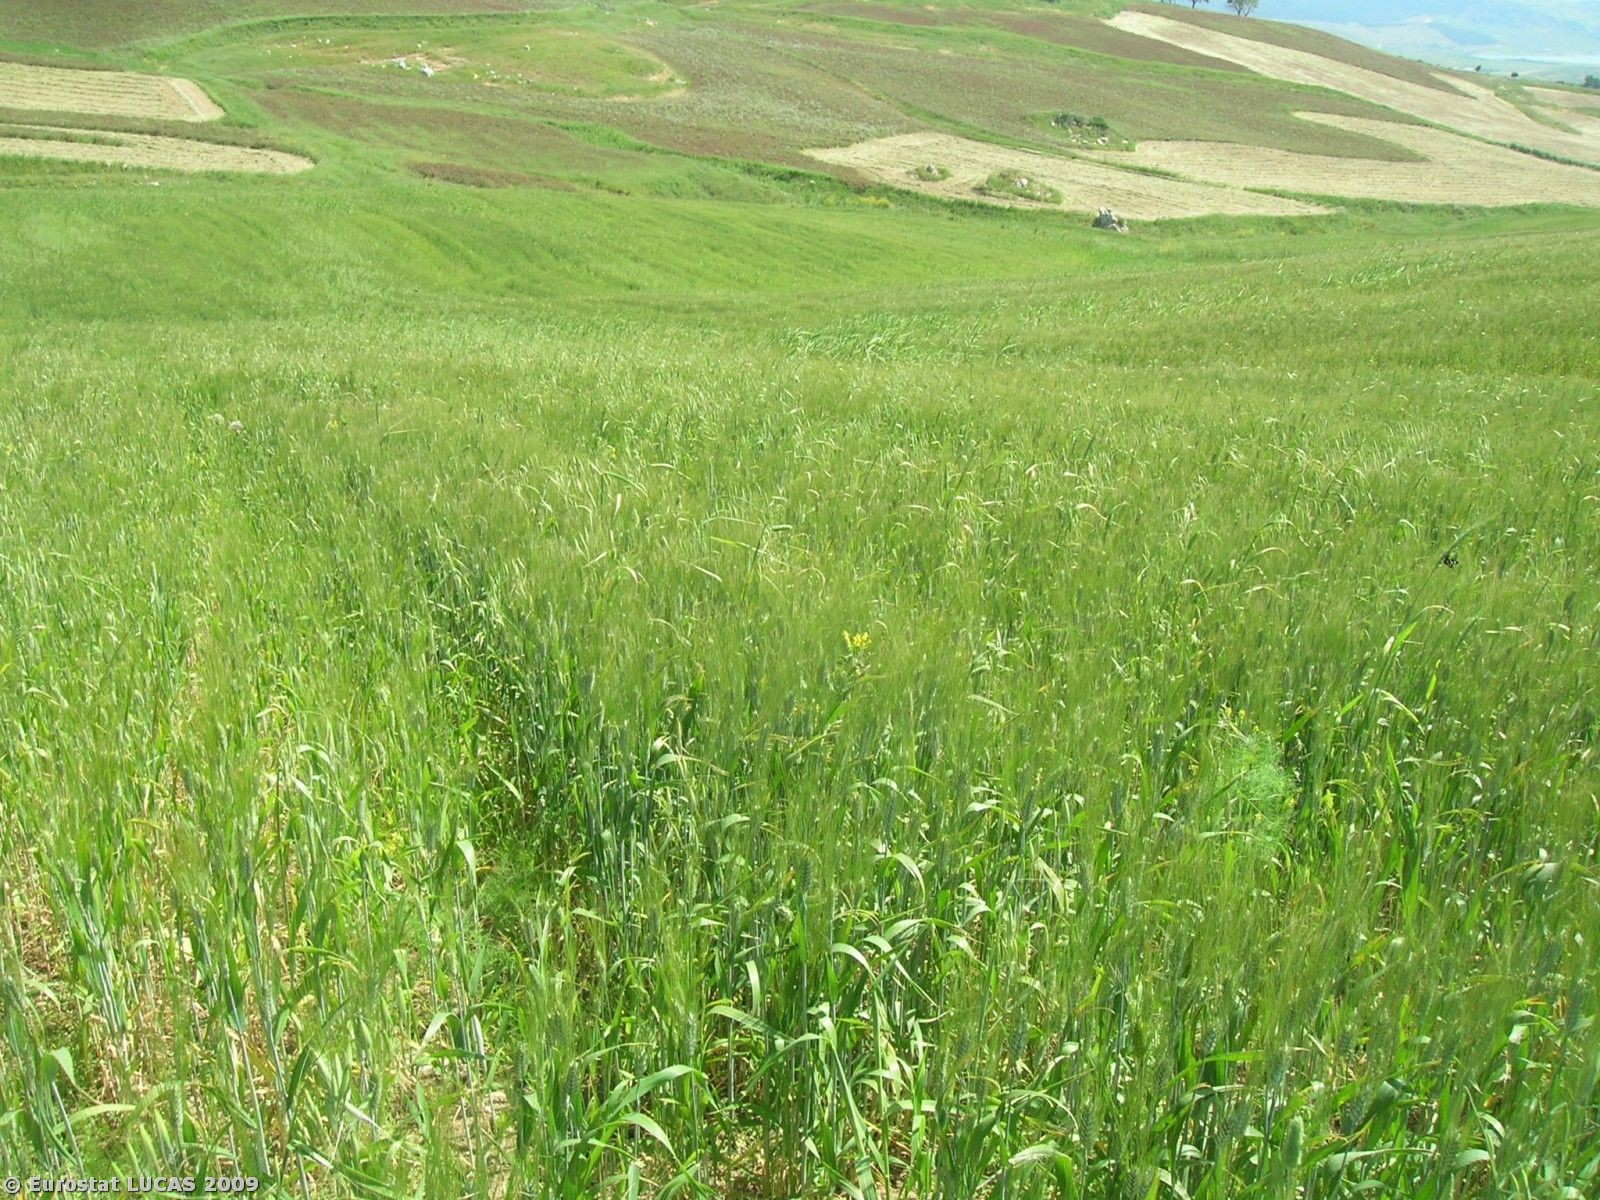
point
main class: Cropland
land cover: Durum wheat
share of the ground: > 75 %
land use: Agriculture (excluding fallow land and kitchen gardens)
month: May
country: IT
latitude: 37.6964
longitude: 13.1182
